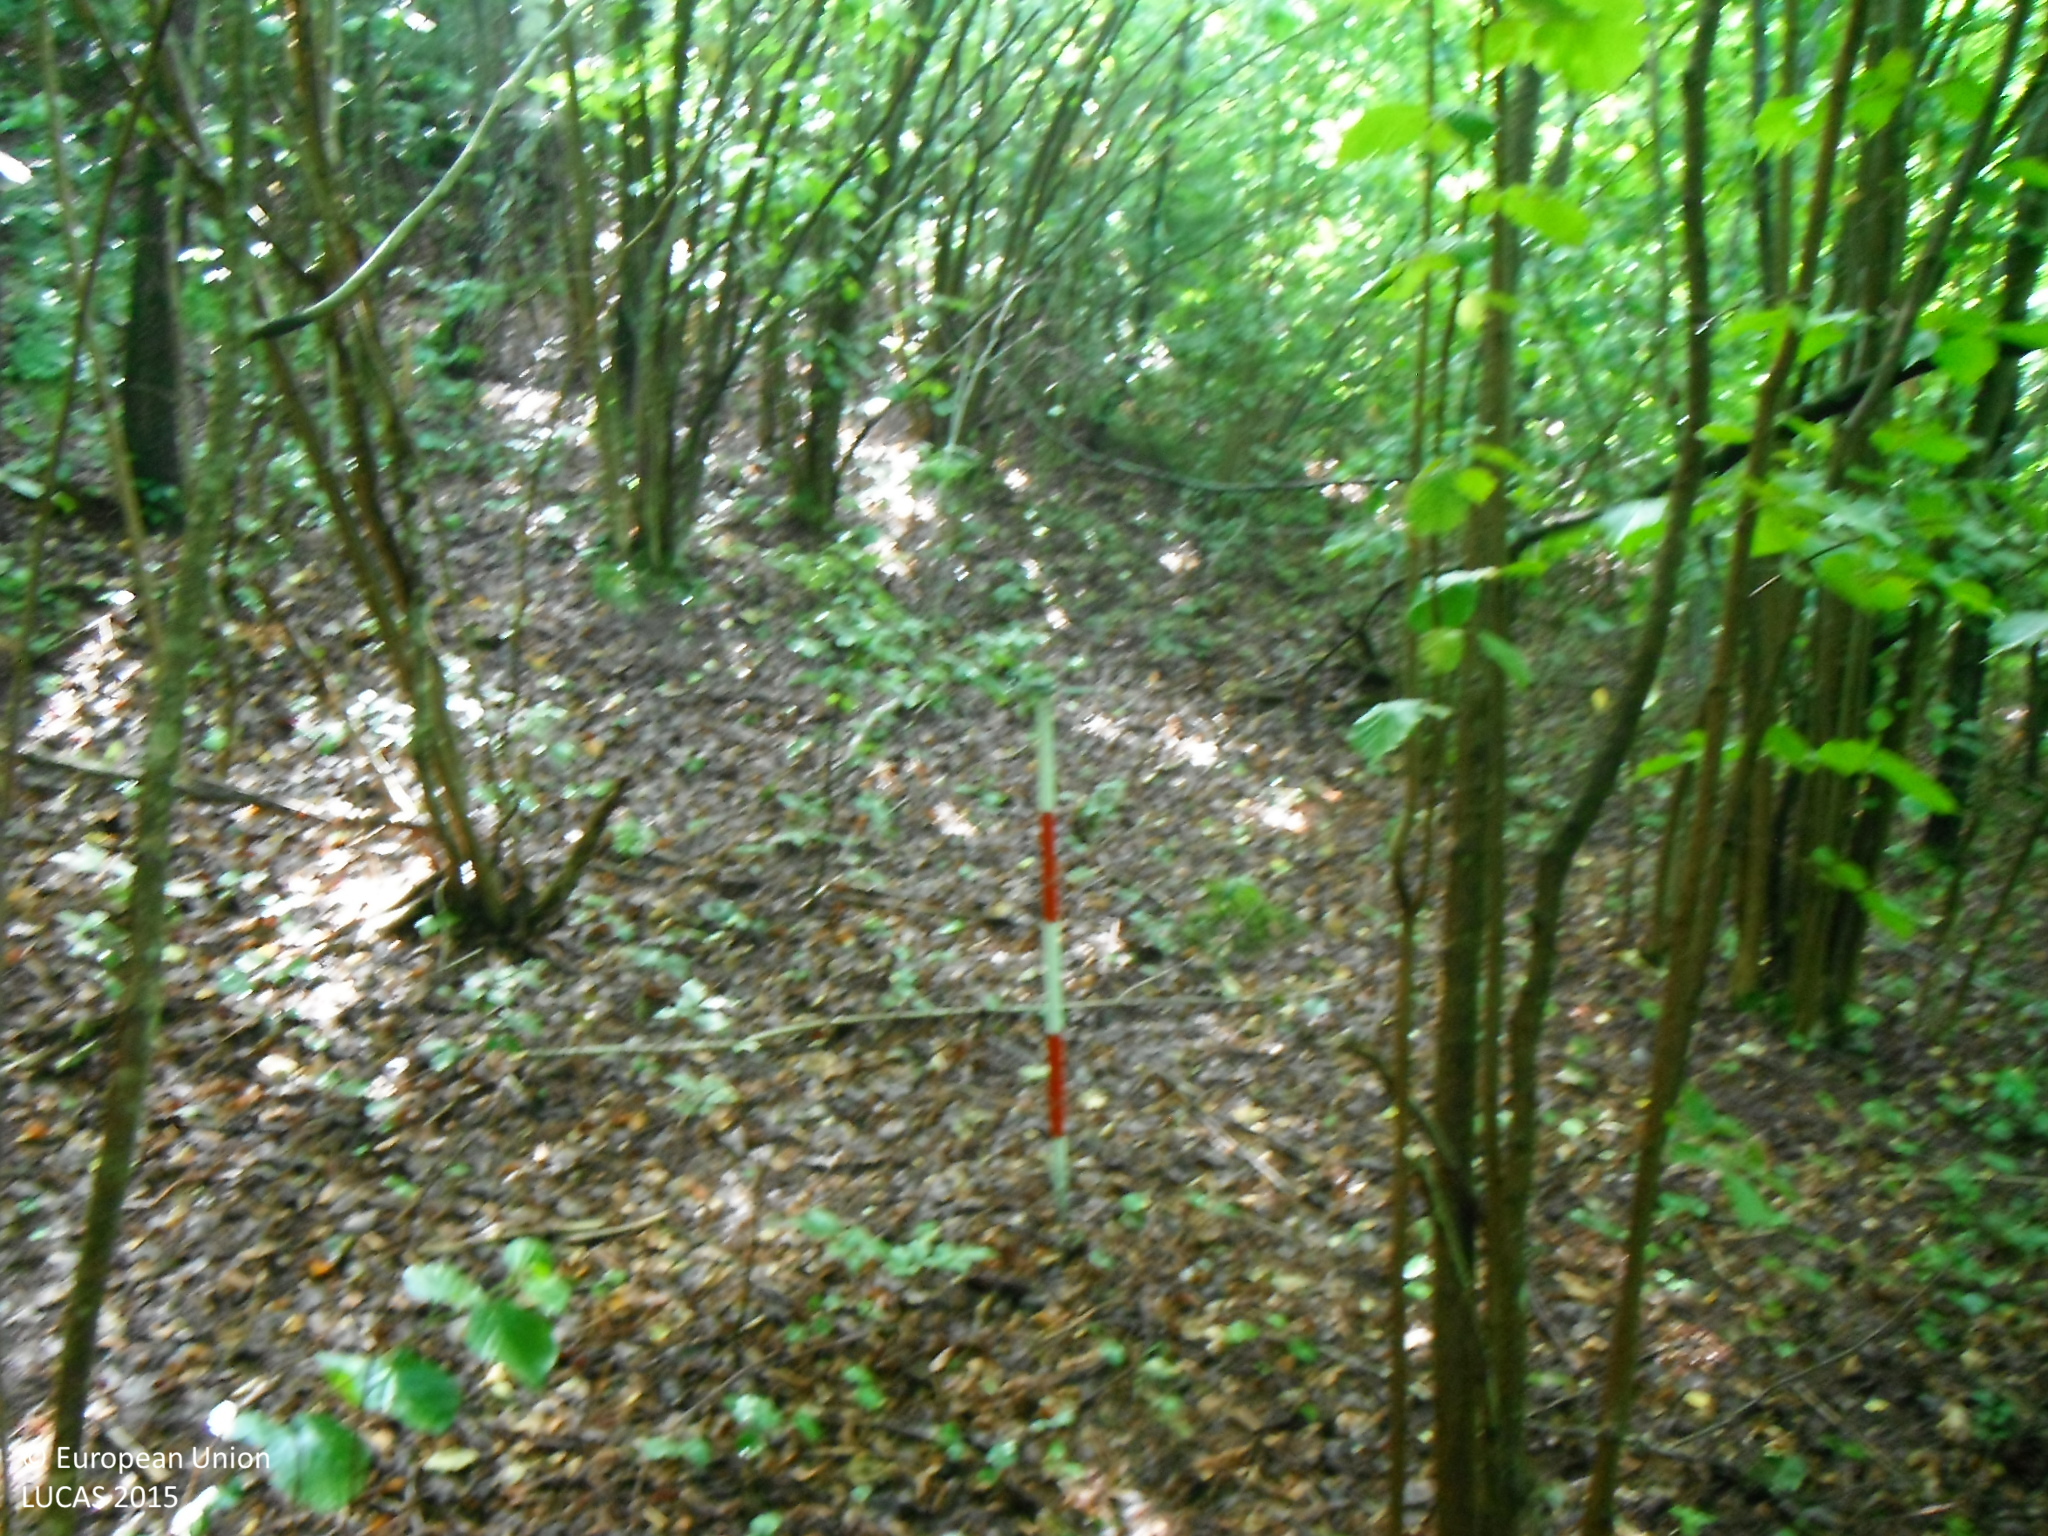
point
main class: Woodland
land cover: Broadleaved woodland
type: mesophytic deciduous forest
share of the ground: > 75 %
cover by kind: broadleaved forest trees 100 %
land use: Semi-natural and natural areas not in use
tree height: > 5 m
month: July
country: SK
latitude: 48.8538
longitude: 19.6078
